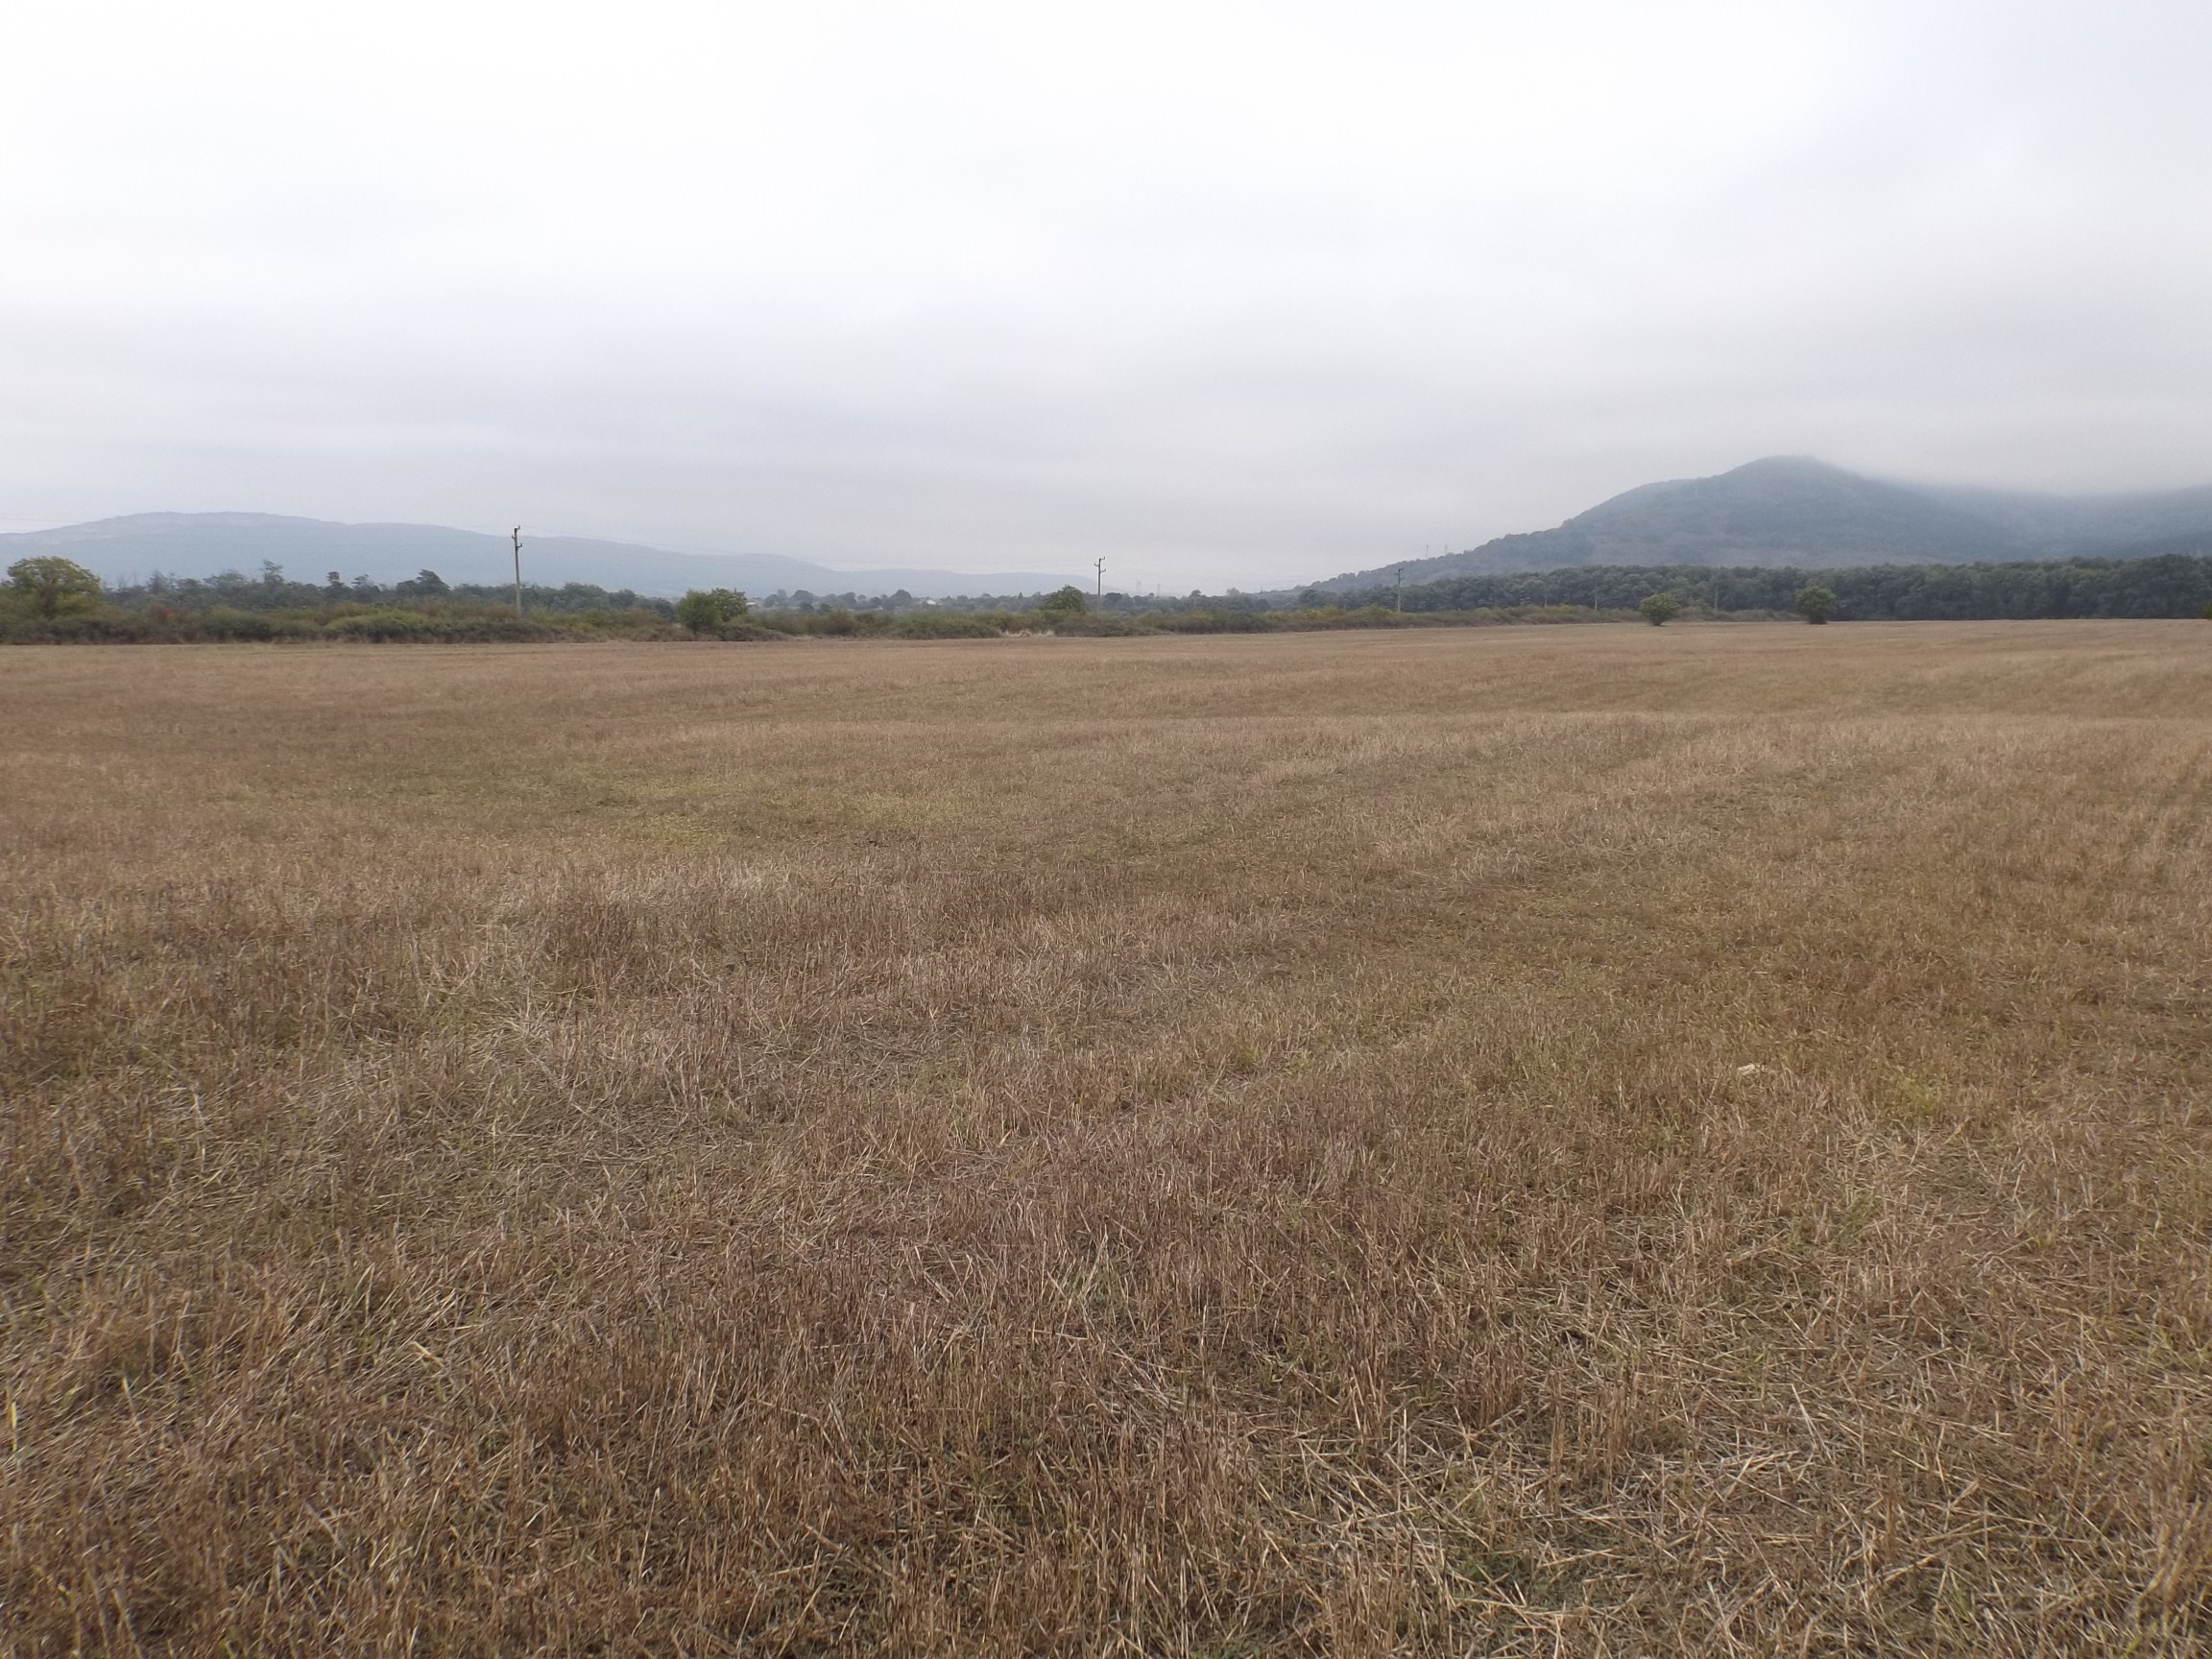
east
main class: Cropland
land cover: Common wheat
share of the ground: 25 - 50 %
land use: Agriculture (excluding fallow land and kitchen gardens)
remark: Harvested field
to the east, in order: Common wheat; Shrubland with sparse tree cover; Electric lines; Shrubland with sparse tree cover; Common wheat
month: October
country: BG
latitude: 43.0063
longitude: 27.2312
